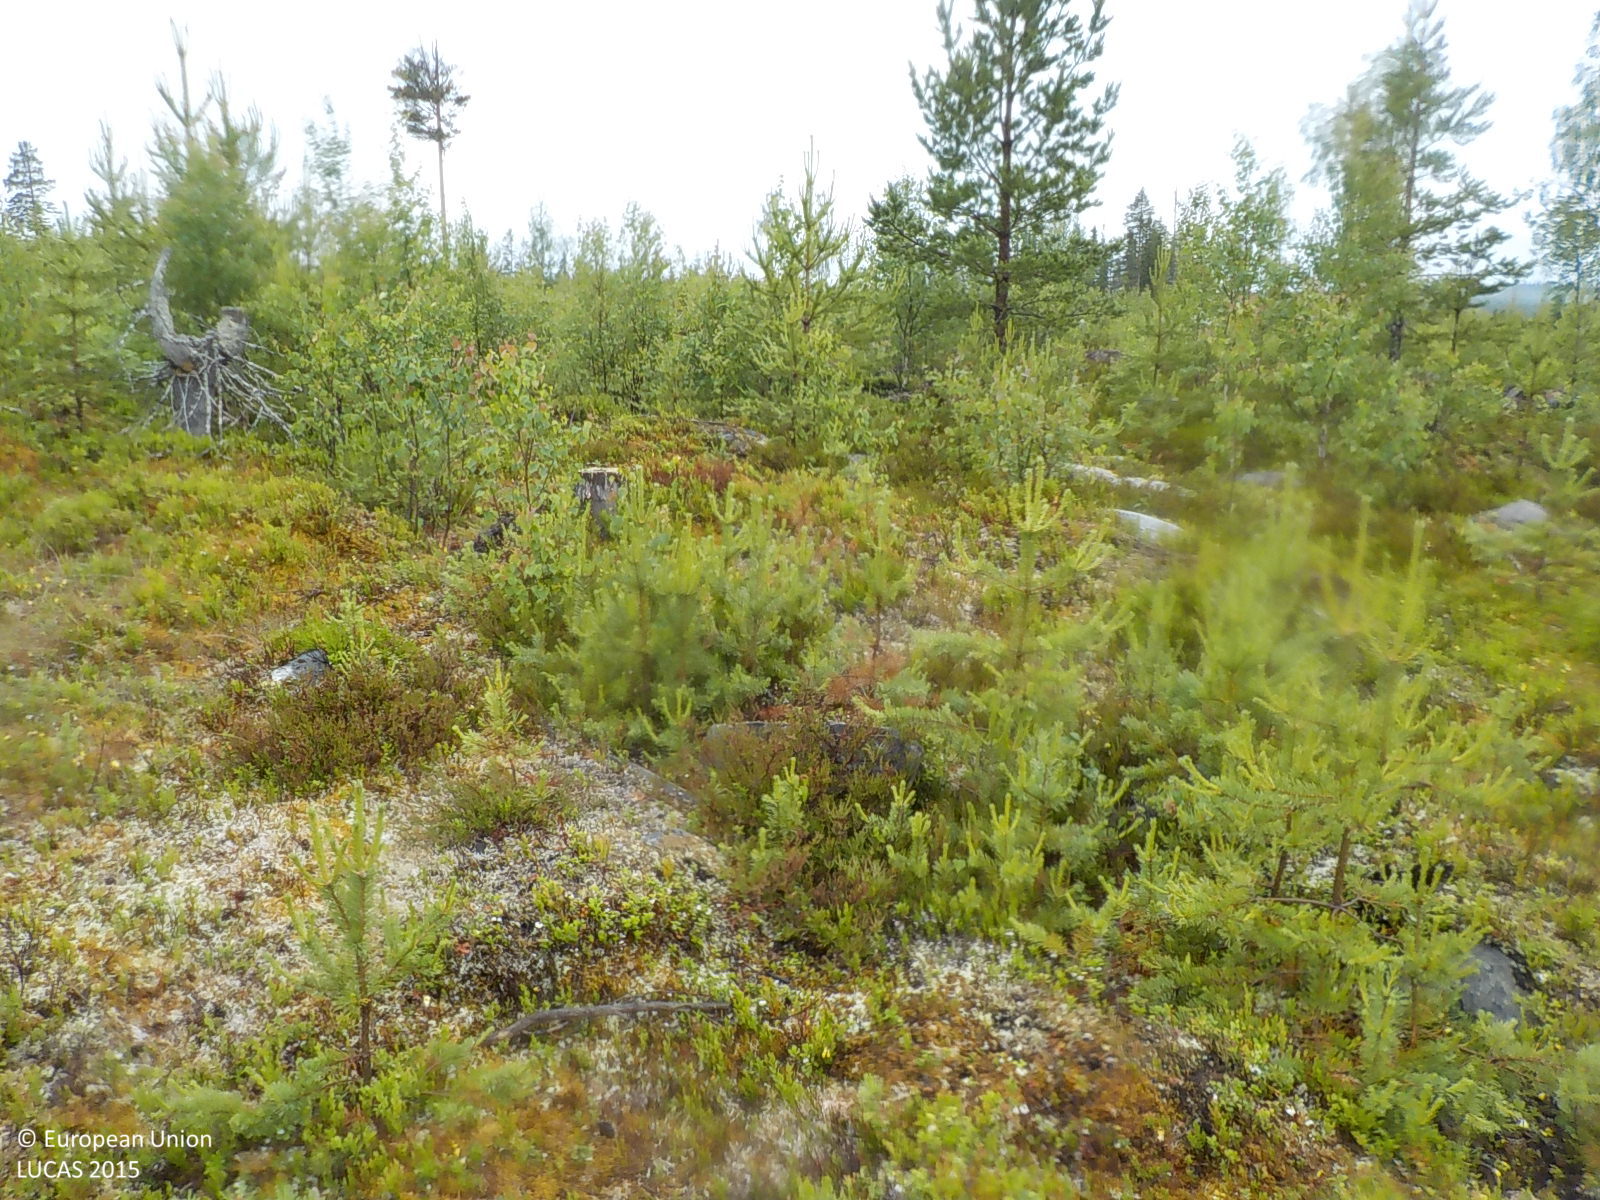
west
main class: Woodland
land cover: Other mixed woodland
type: boreal forest
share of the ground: 50 - 75 %
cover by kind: shrubs 50 %, coniferous forest trees 30 %, broadleaved forest trees 20 %
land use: Forestry
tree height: < 5 m
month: July
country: SE
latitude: 63.0116
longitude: 16.9883
